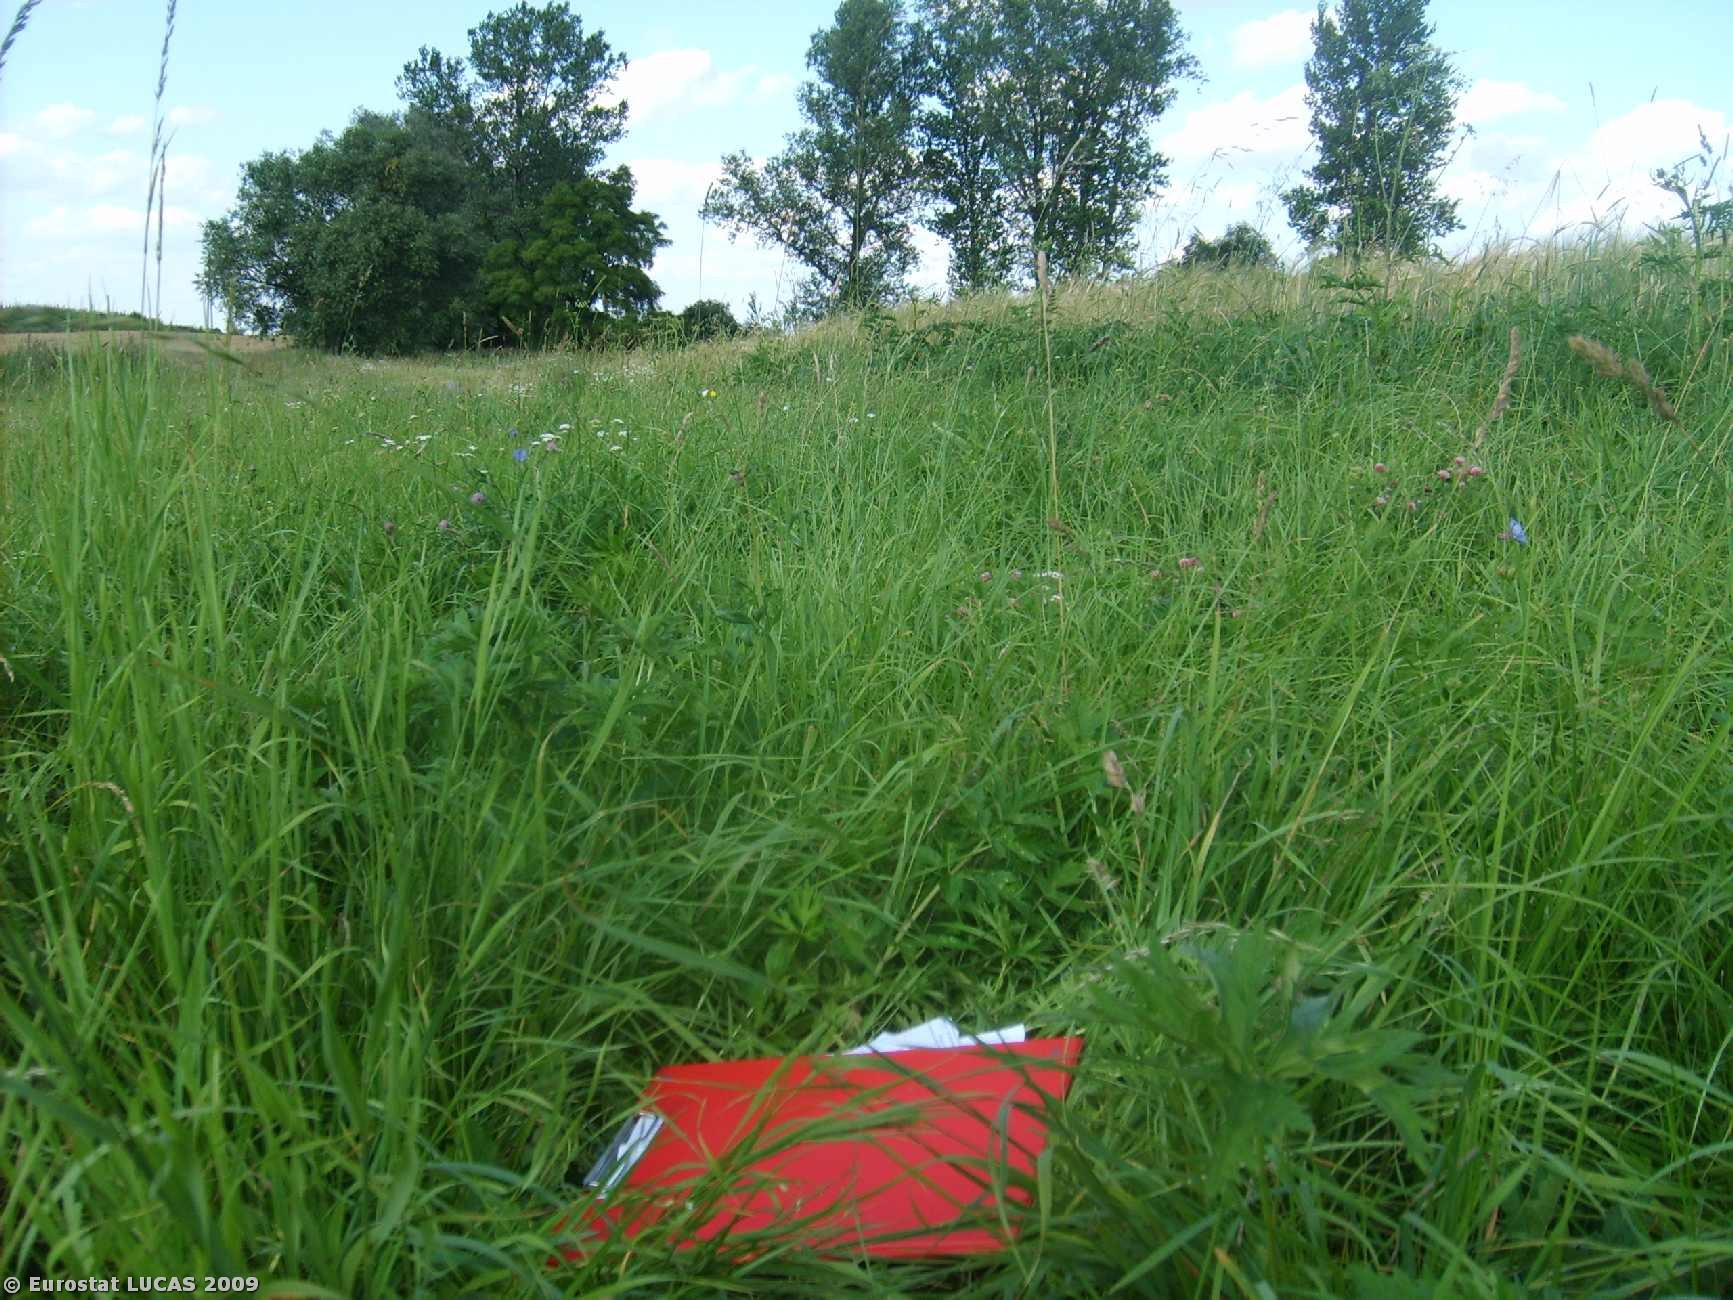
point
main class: Grassland
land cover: Grassland without tree/shrub cover
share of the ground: > 75 %
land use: Agriculture (excluding fallow land and kitchen gardens)
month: July
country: PL
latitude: 50.5100
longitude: 23.7816
